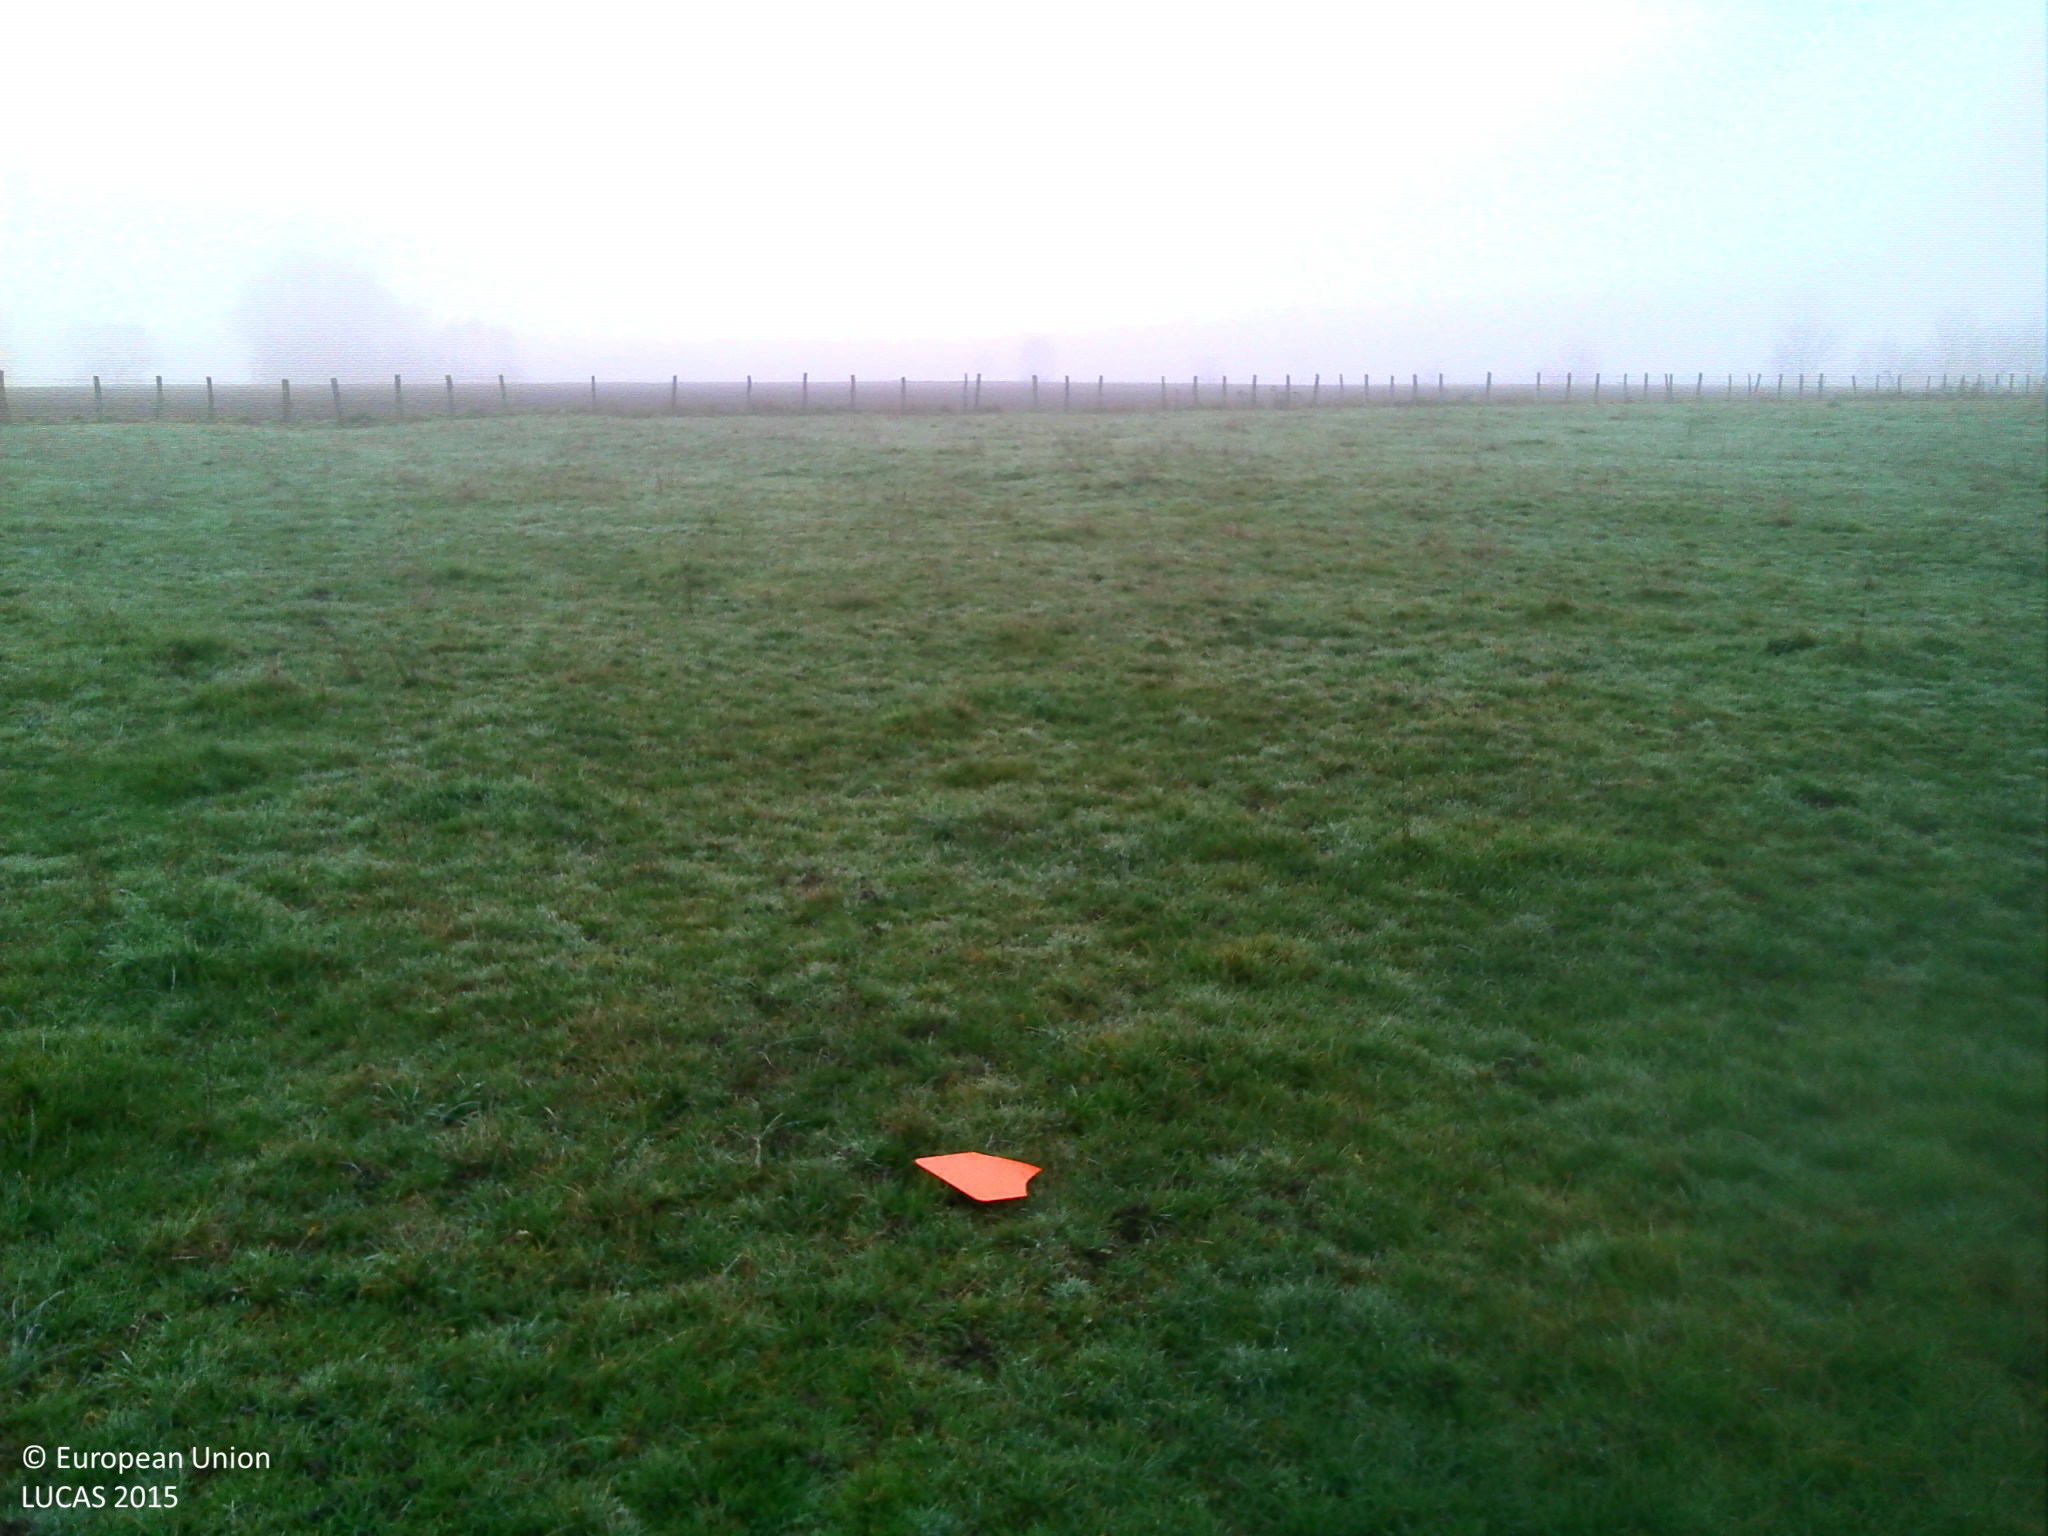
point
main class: Grassland
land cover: Grassland without tree/shrub cover
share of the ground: > 75 %
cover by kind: herbaceous plants 100 %
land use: Agriculture (excluding fallow land and kitchen gardens)
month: December
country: FR
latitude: 46.9605
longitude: 5.0995
